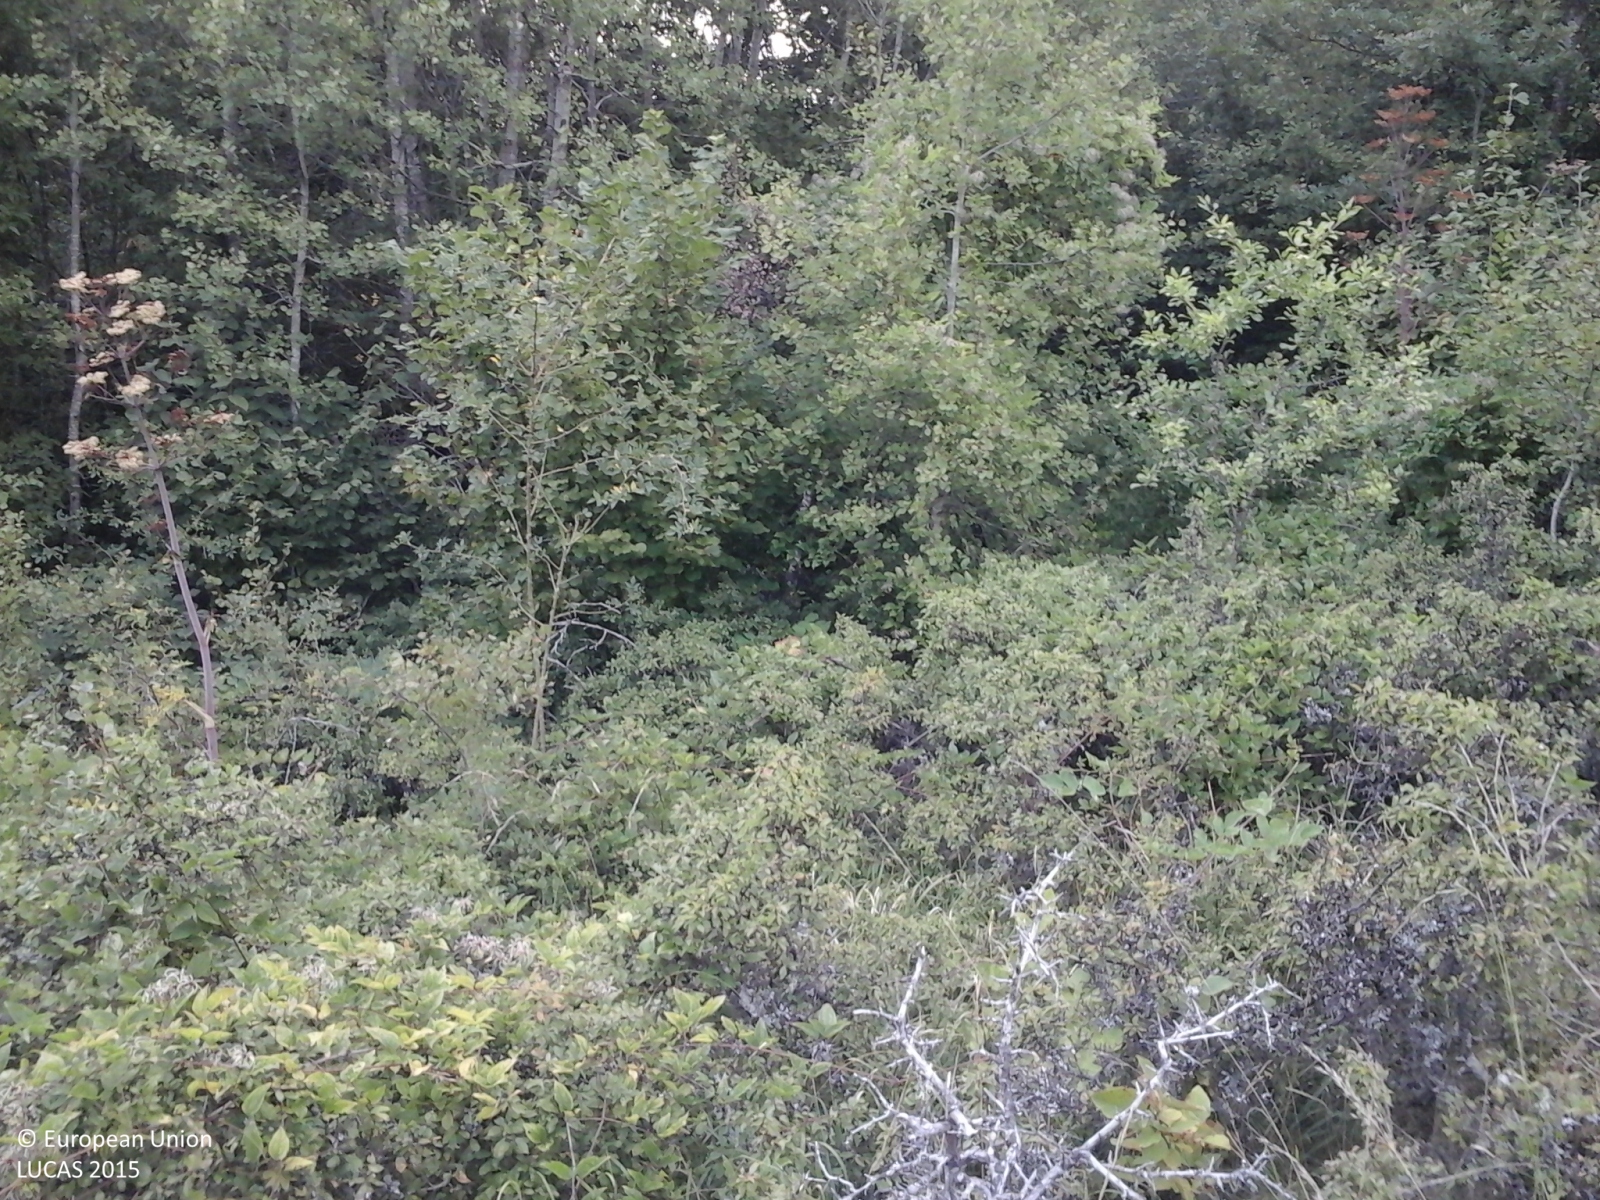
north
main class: Woodland
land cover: Broadleaved woodland
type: thermophilous deciduous forest
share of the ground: > 75 %
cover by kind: broadleaved forest trees 40 %, shrubs 40 %, herbaceous plants 15 %, coniferous forest trees 5 %
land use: Semi-natural and natural areas not in use
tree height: > 5 m
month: August
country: IT
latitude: 44.7450
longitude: 9.3068
